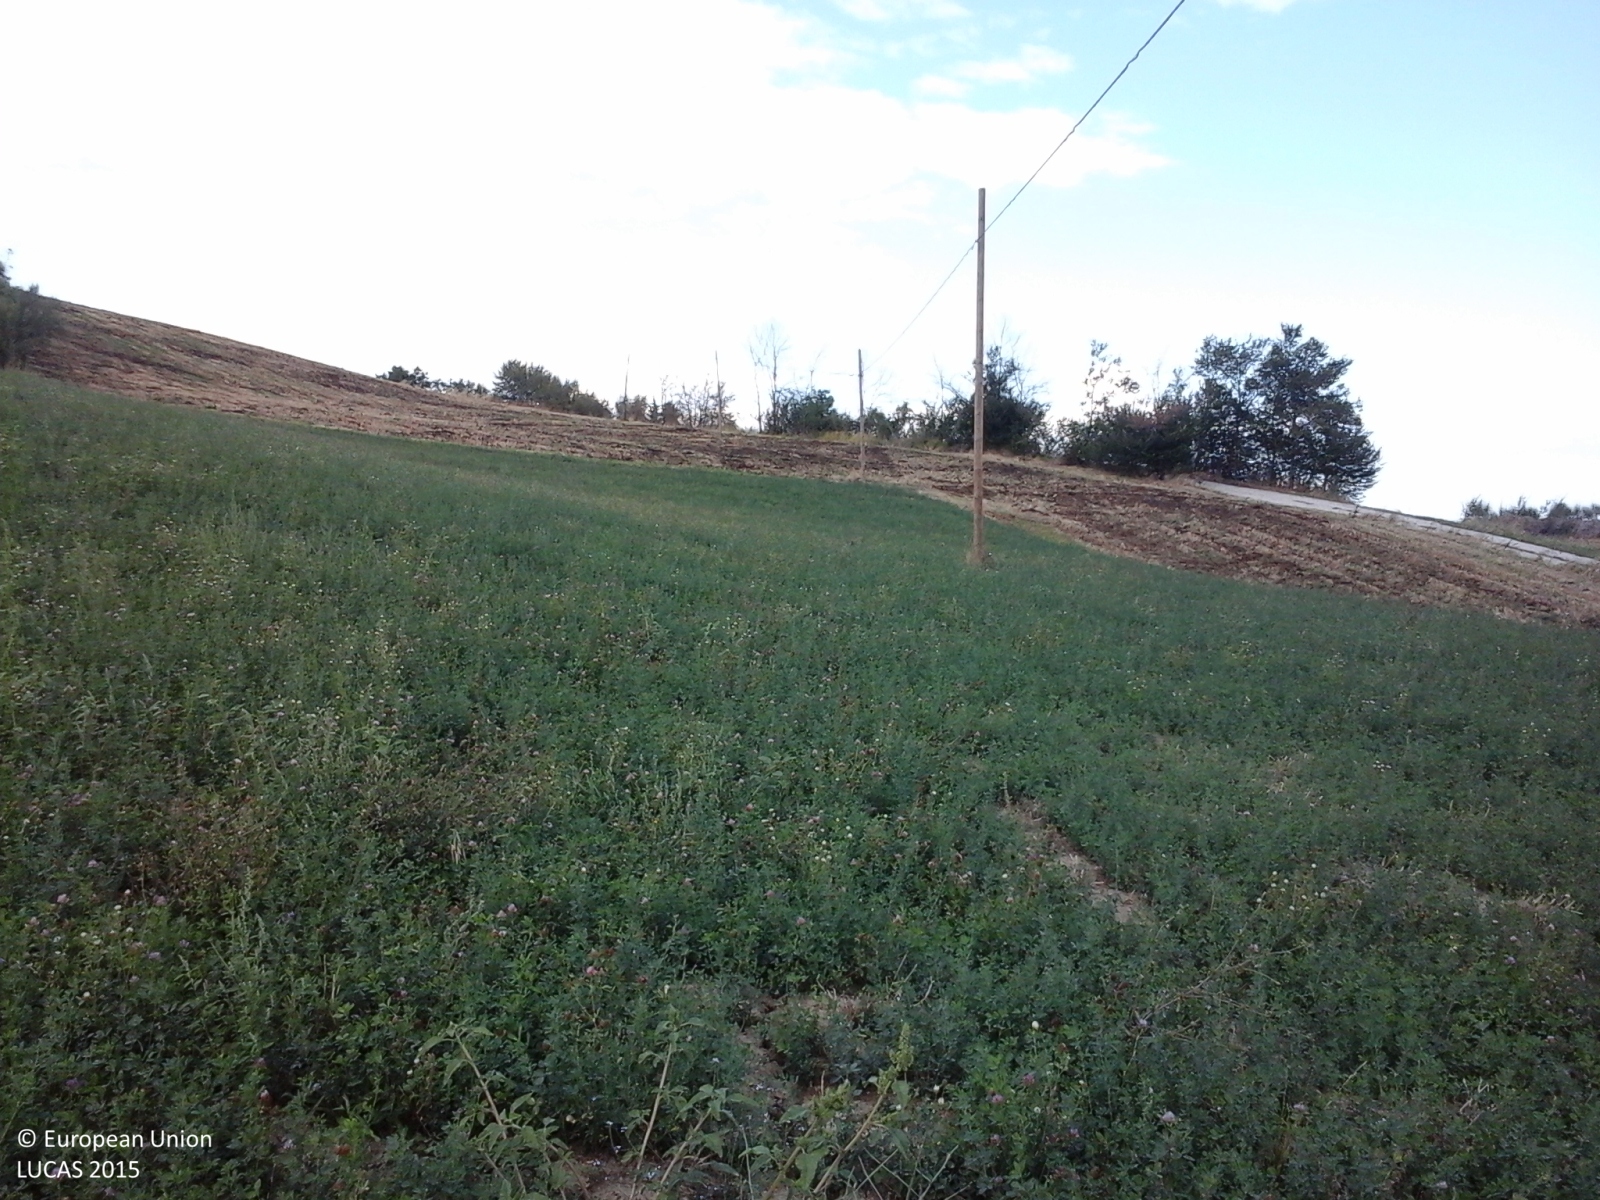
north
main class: Cropland
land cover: Lucerne
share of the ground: > 75 %
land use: Agriculture (excluding fallow land and kitchen gardens)
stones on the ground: < 10 %
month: August
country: IT
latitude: 42.5628
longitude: 13.8499
